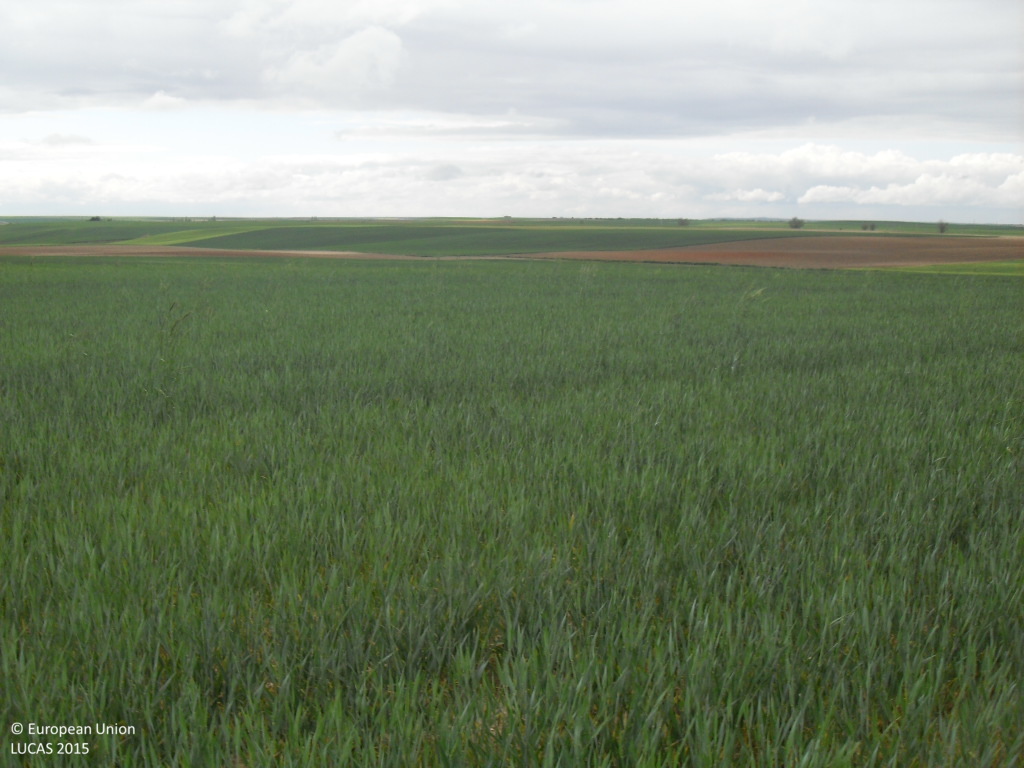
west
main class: Cropland
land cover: Common wheat
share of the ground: > 75 %
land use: Agriculture (excluding fallow land and kitchen gardens)
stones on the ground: 10 - 25 %
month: April
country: ES
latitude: 40.8861
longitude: -5.2475
